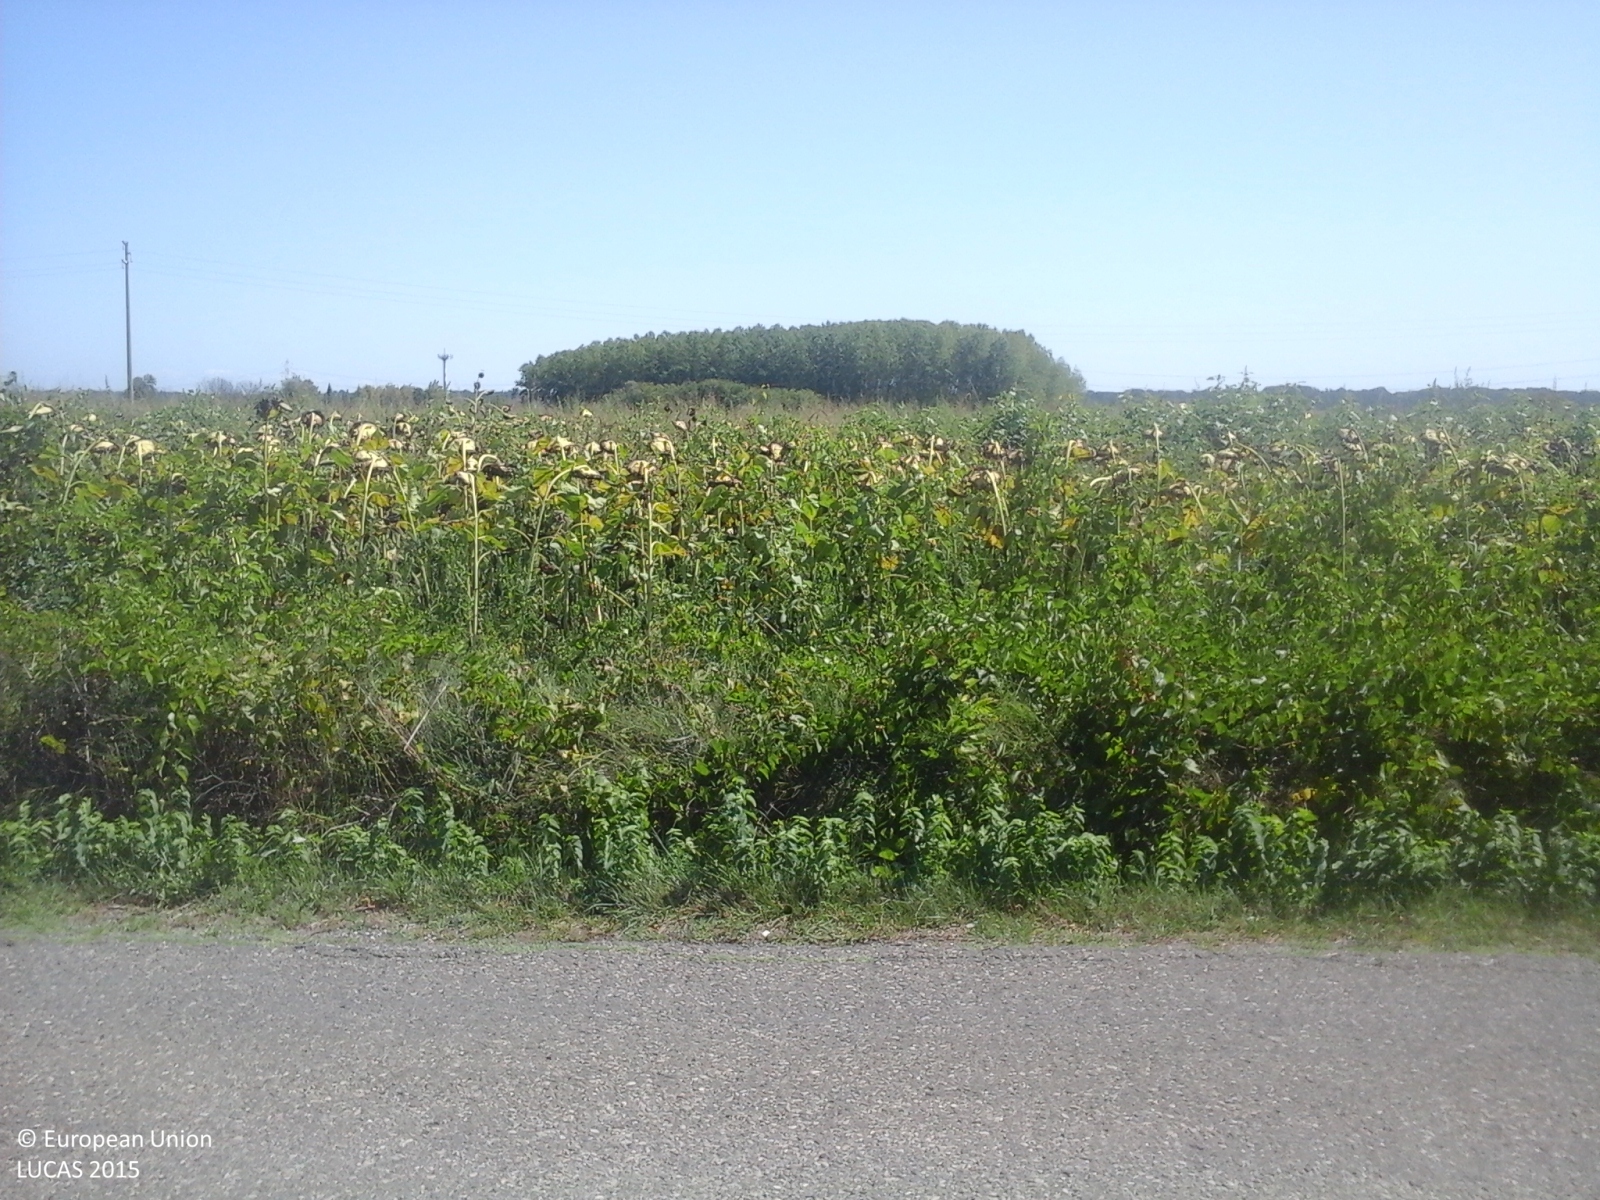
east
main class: Cropland
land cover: Sunflower
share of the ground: > 75 %
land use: Agriculture (excluding fallow land and kitchen gardens)
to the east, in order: Sunflower; Ditches and canals; Sunflower; Ditches and canals; Sunflower; Ditches and canals; Sunflower; Ditches and canals; Sunflower; Ditches and canals; Sunflower; Ditches and canals; Sunflower; Ditches and canals; Grass margins; Paved roads, cycling and walking lanes; Grass margins; Ditches and canals; Electric lines; Sunflower; Ditches and canals; Sunflower; Ditches and canals; Sunflower
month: August
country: IT
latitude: 43.6993
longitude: 10.6064
